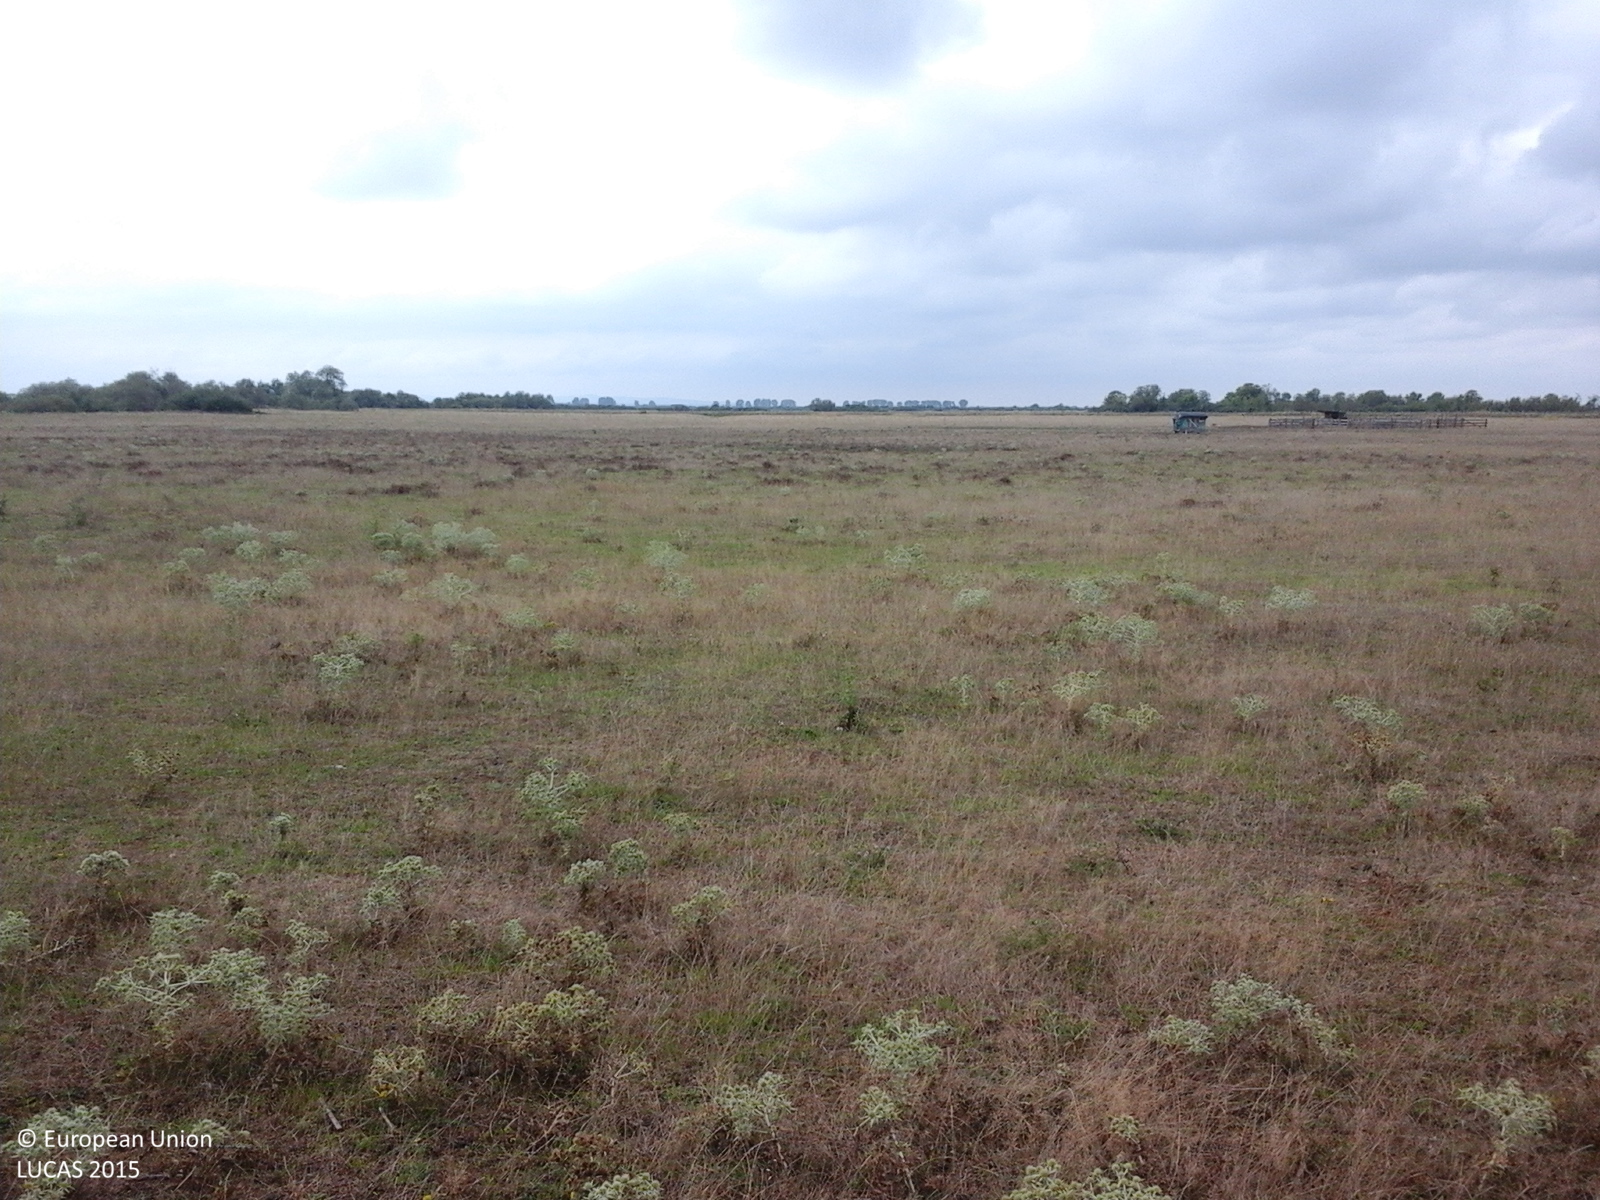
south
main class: Grassland
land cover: Grassland without tree/shrub cover
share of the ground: > 75 %
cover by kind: herbaceous plants 100 %
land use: Agriculture (excluding fallow land and kitchen gardens)
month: August
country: RO
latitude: 45.8063
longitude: 21.7857
